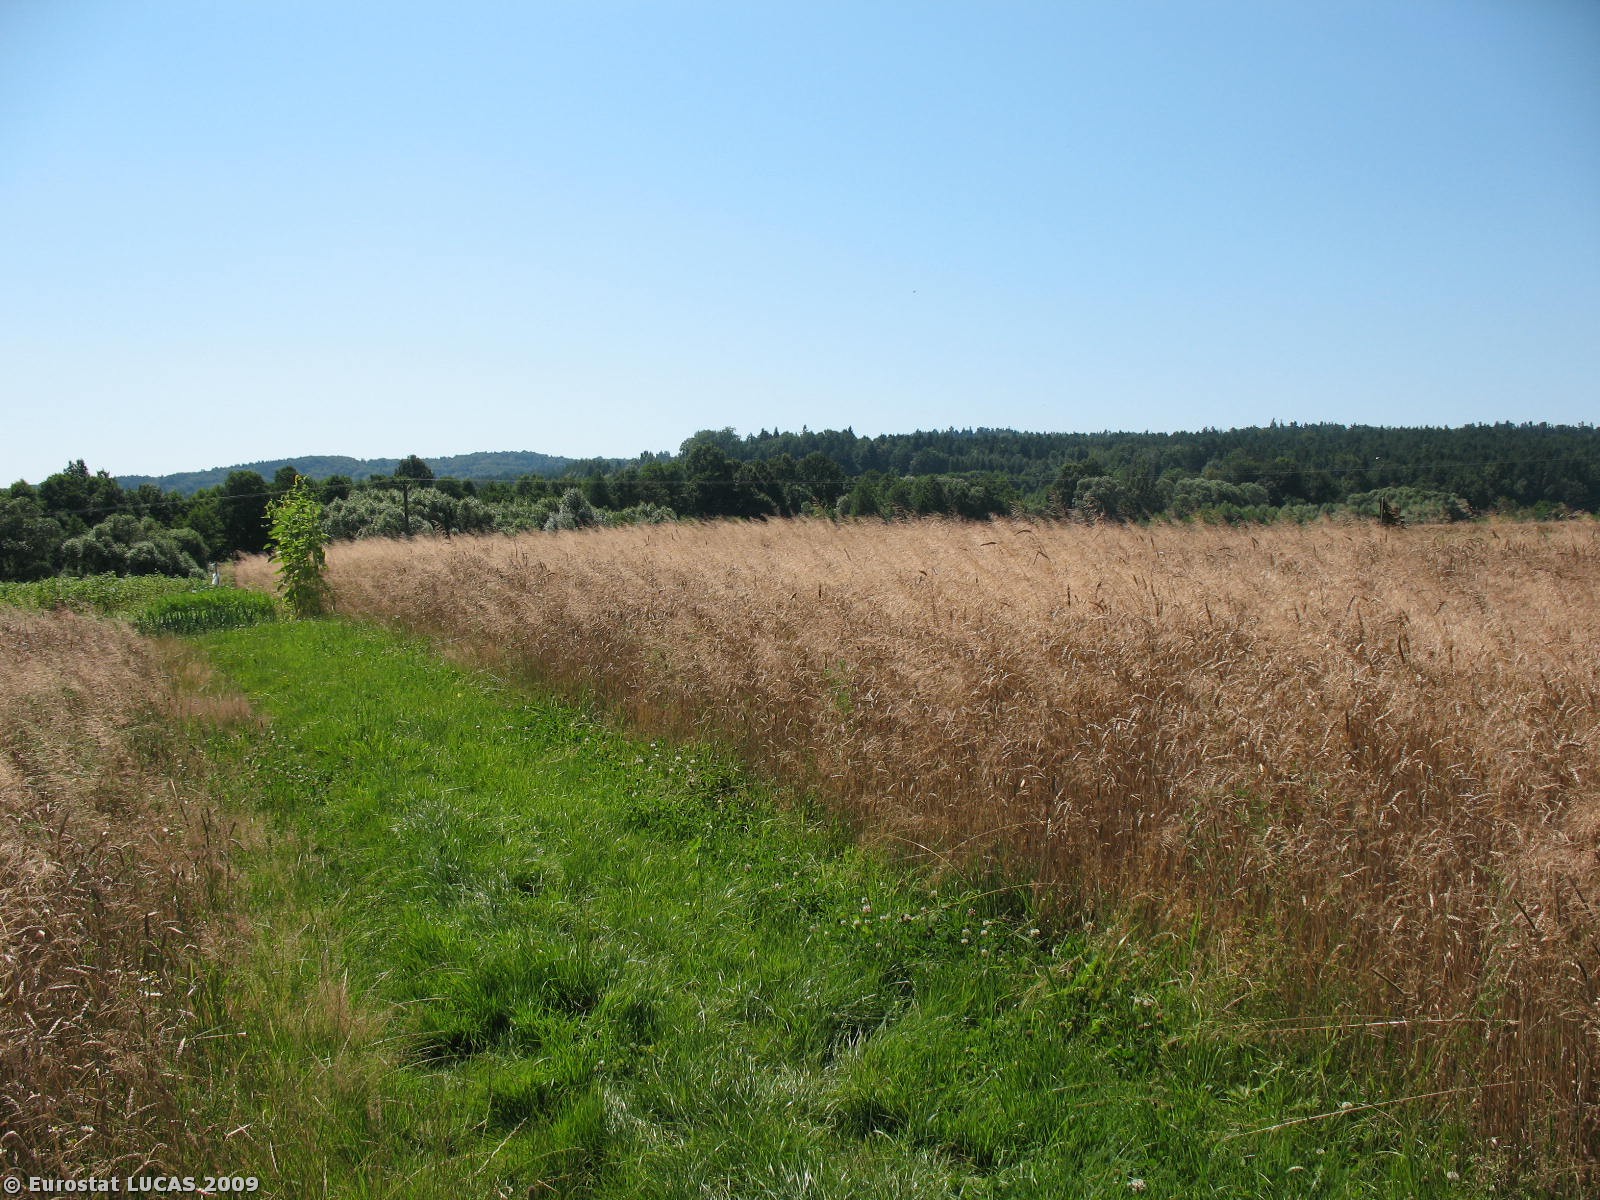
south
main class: Grassland
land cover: Grassland without tree/shrub cover
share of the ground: > 75 %
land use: Agriculture (excluding fallow land and kitchen gardens)
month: July
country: PL
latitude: 49.7146
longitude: 21.9699
